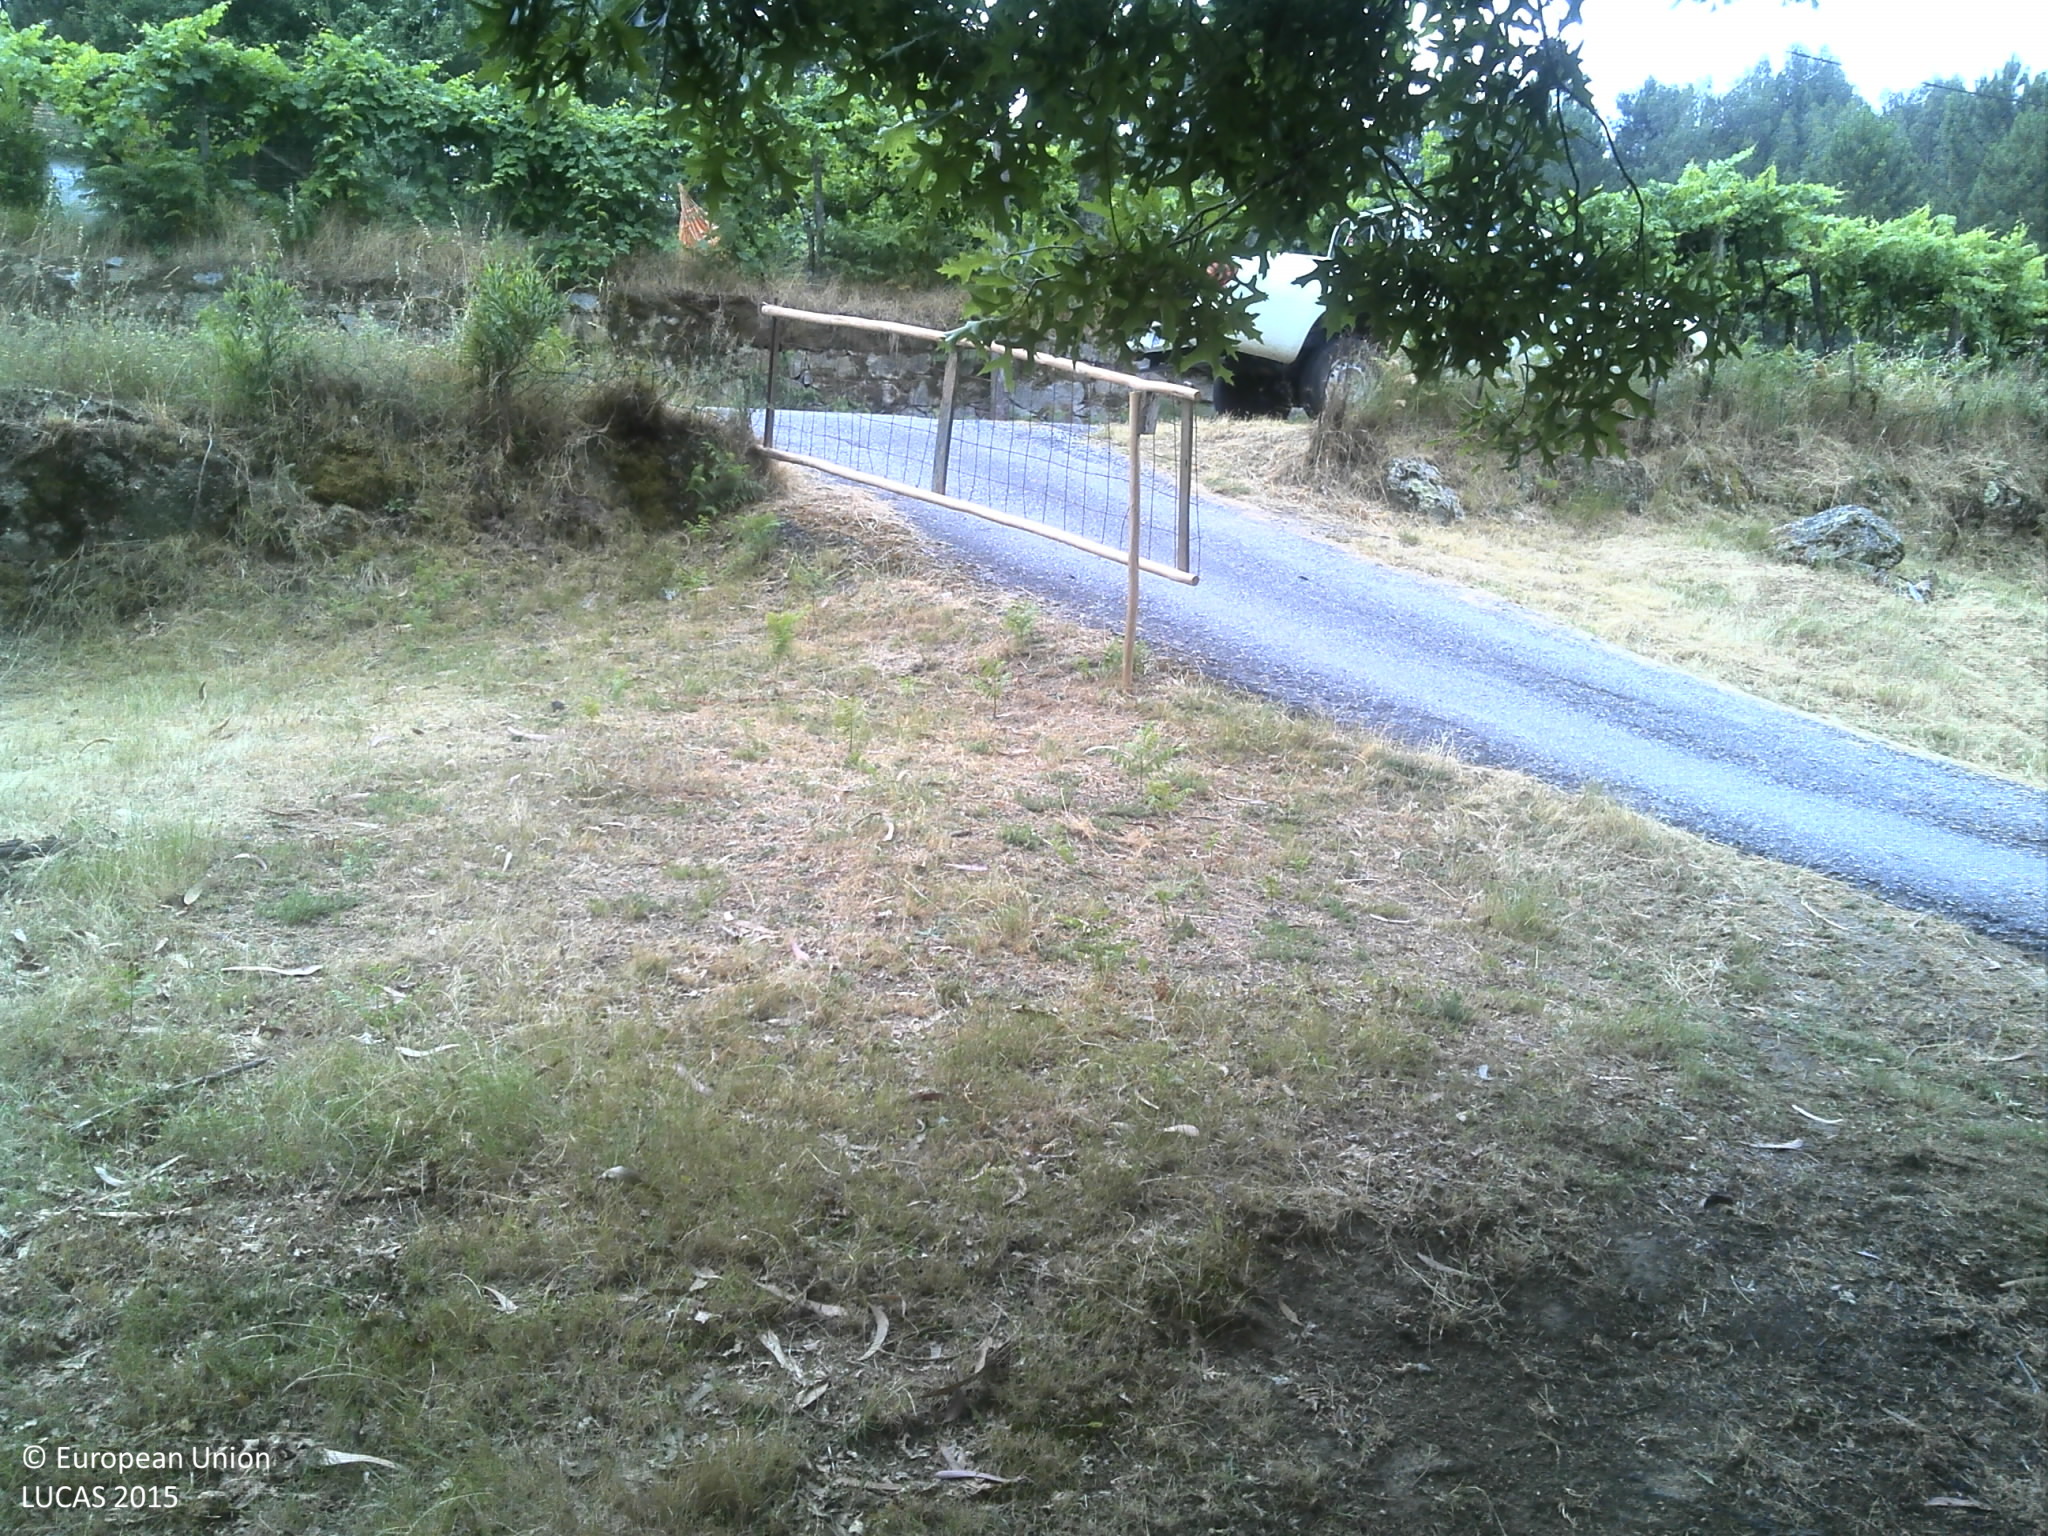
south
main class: Woodland
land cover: Broadleaved woodland
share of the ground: > 75 %
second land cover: Grassland without tree/shrub cover
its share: 10 - 25 %
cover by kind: broadleaved forest trees 75 %, unconsolidated bare surface 15 %, herbaceous plants 10 %
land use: Forestry
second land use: Agriculture (excluding fallow land and kitchen gardens)
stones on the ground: < 10 %
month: June
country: PT
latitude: 41.1602
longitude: -8.1710
